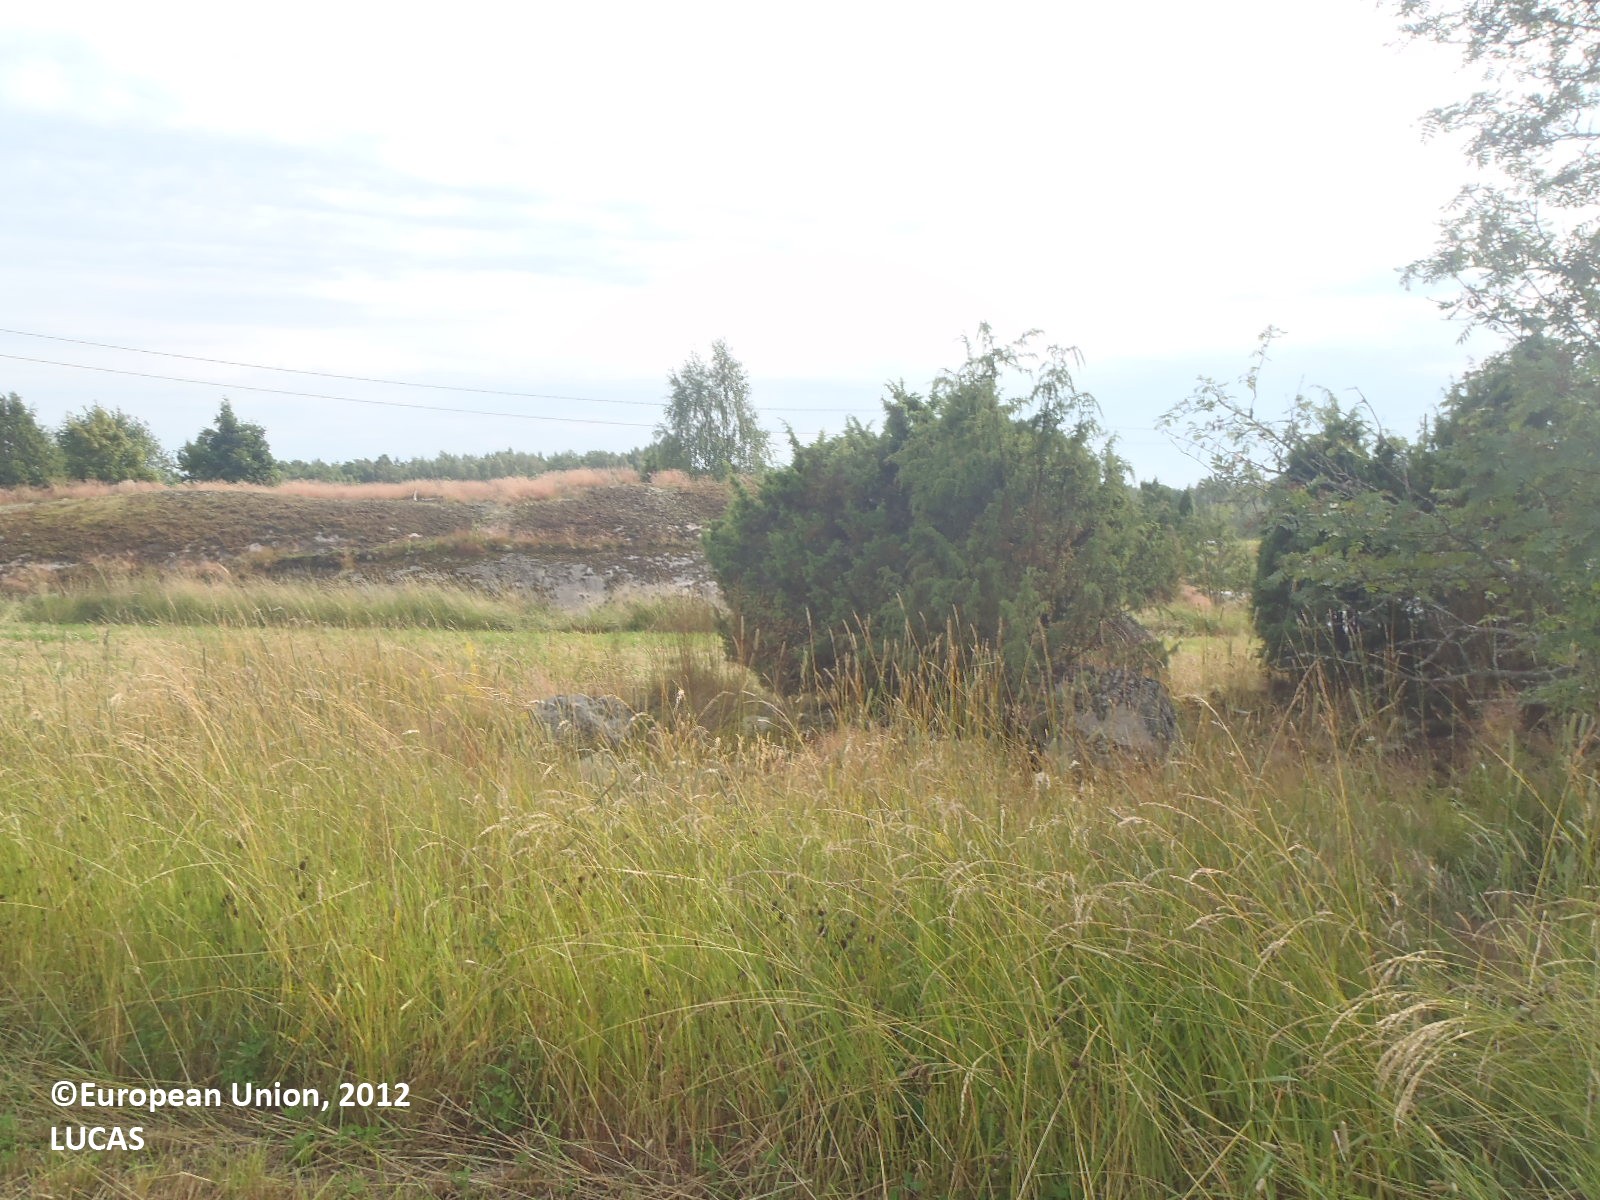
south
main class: Cropland
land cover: Temporary grasslands
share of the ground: > 75 %
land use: Agriculture (excluding fallow land and kitchen gardens)
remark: Harvested field
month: July
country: FI
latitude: 60.3646
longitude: 21.9383
